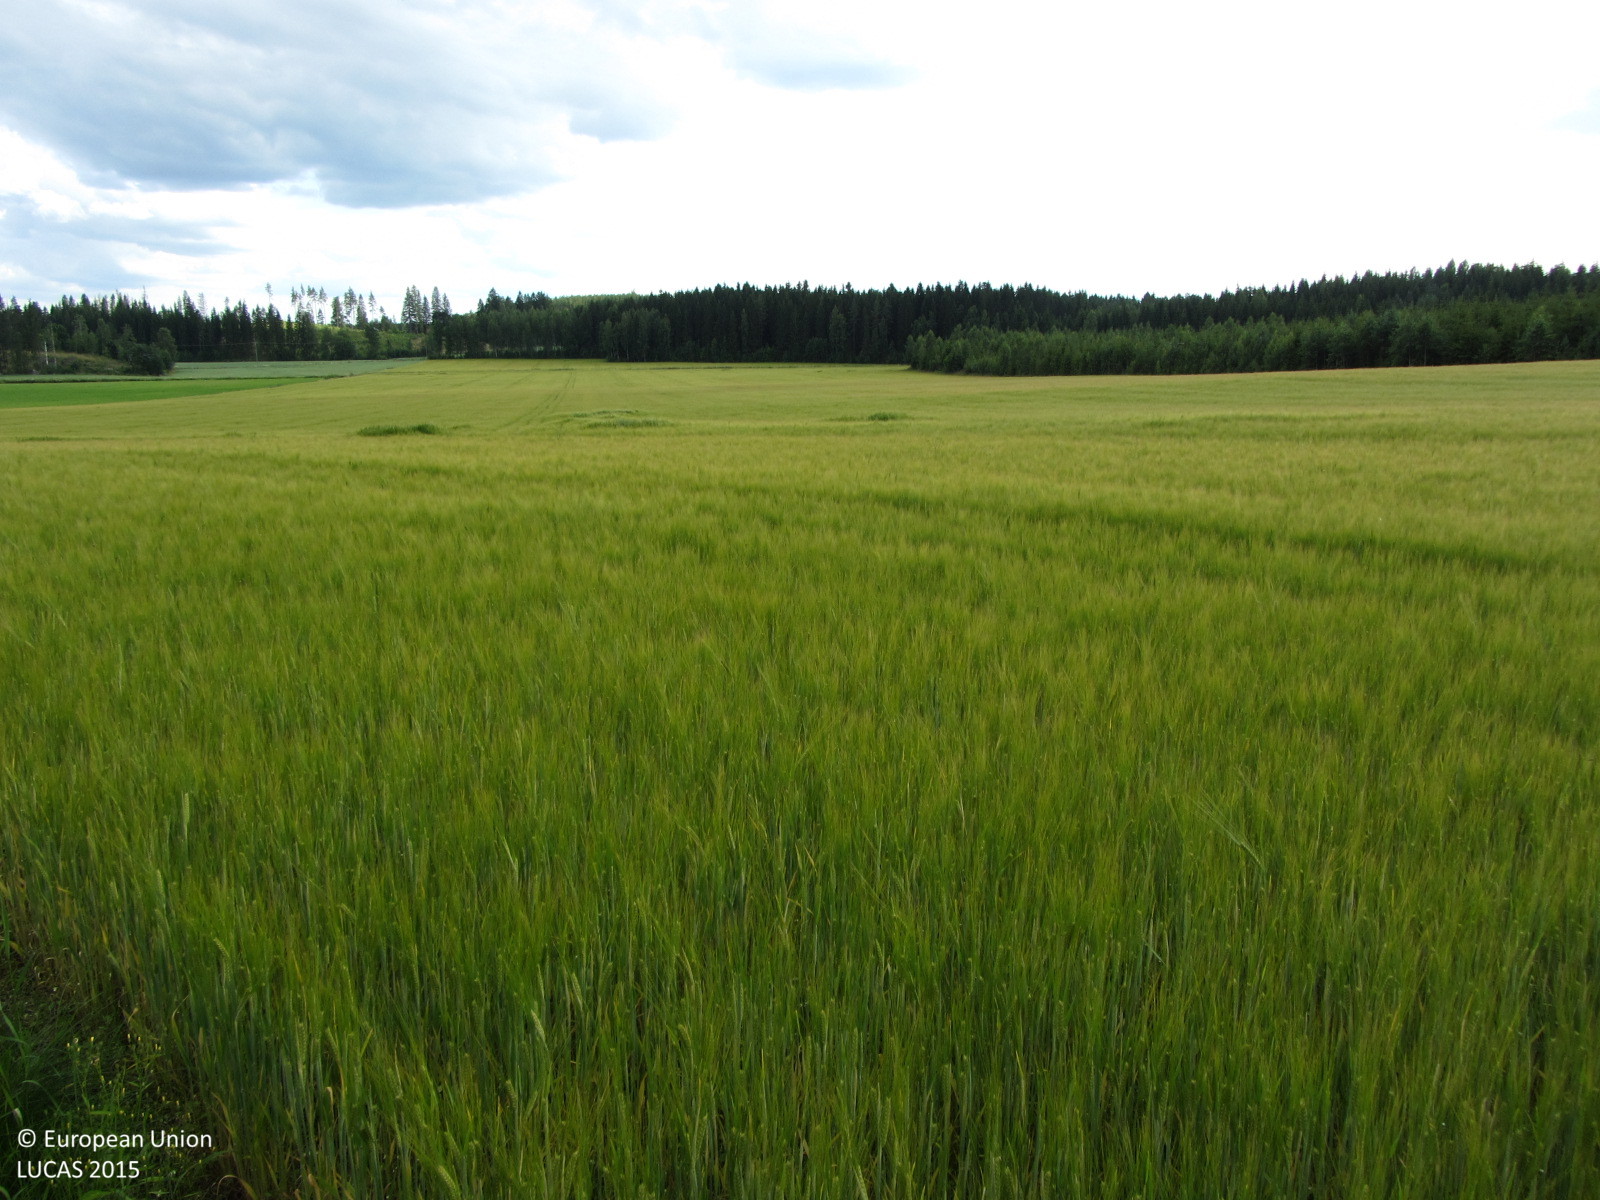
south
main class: Cropland
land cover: Barley
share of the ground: > 75 %
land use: Agriculture (excluding fallow land and kitchen gardens)
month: July
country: FI
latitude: 60.6729
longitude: 24.5097
